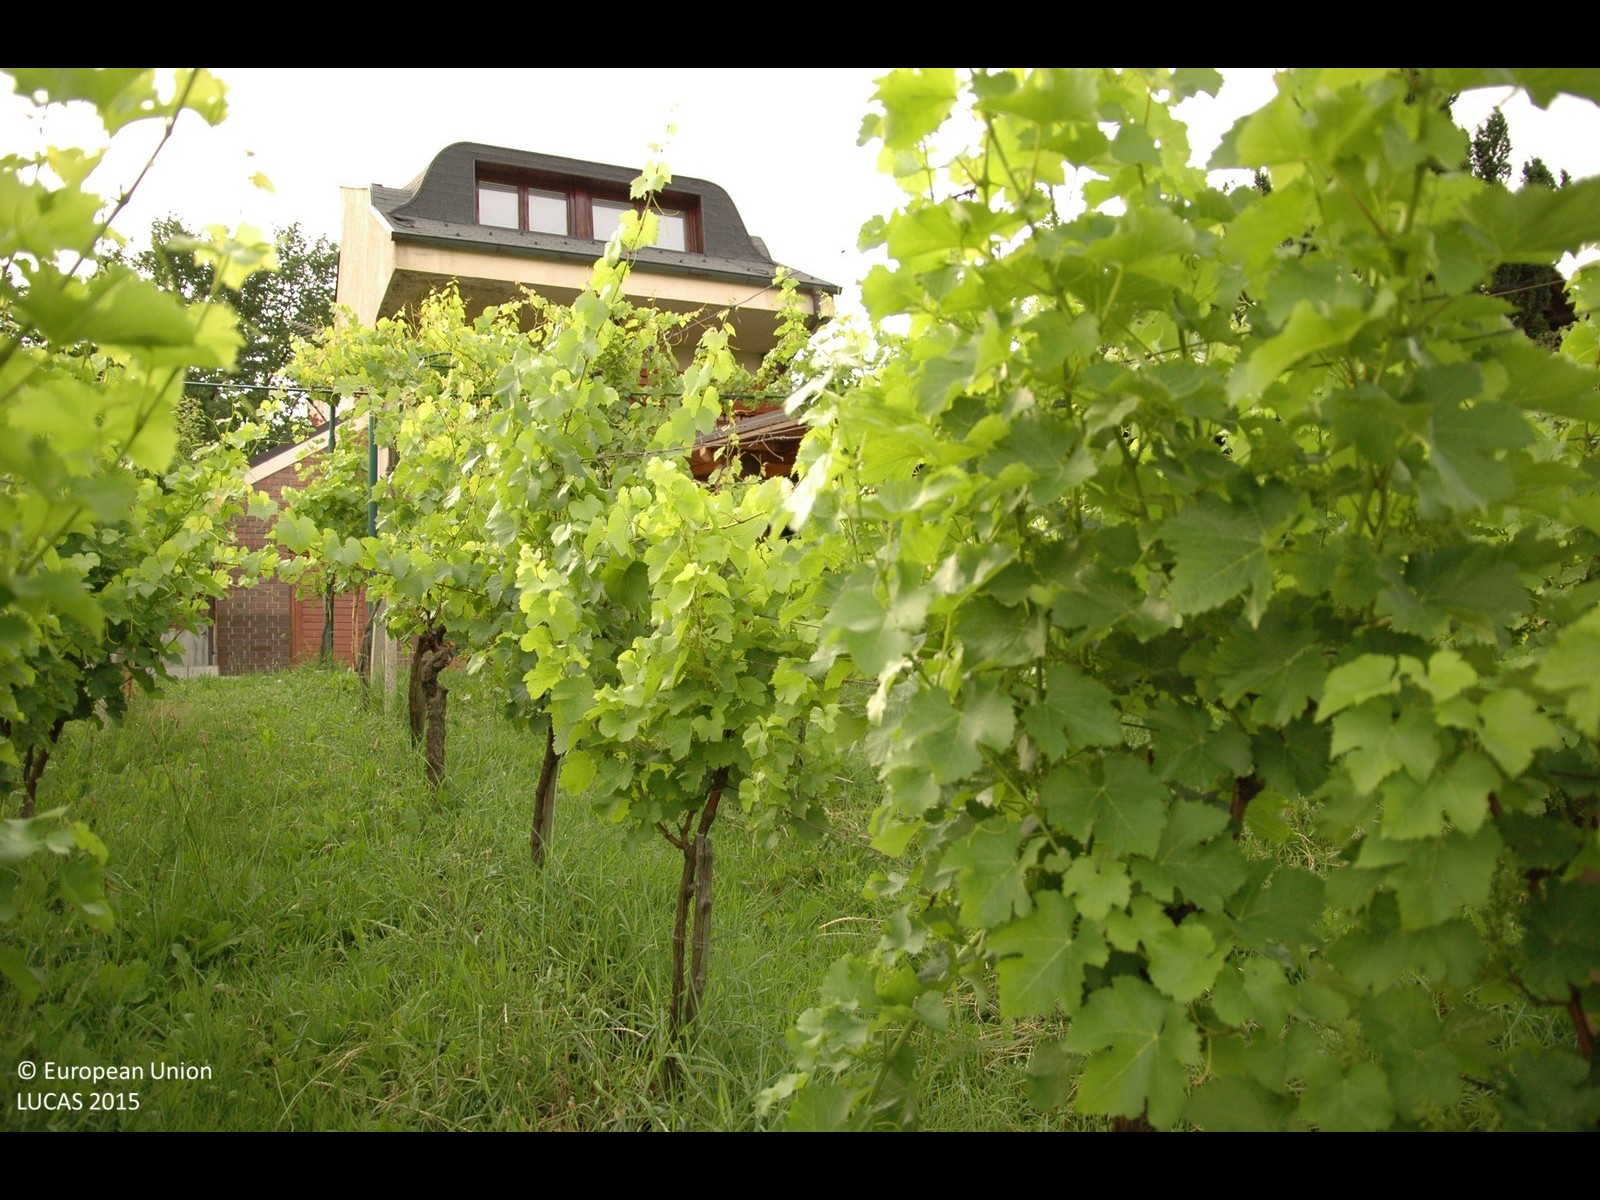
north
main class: Cropland
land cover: Vineyards
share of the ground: 50 - 75 %
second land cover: Grassland without tree/shrub cover
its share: 25 - 50 %
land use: Agriculture (excluding fallow land and kitchen gardens)
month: June
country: HR
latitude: 46.2127
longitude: 16.4164
